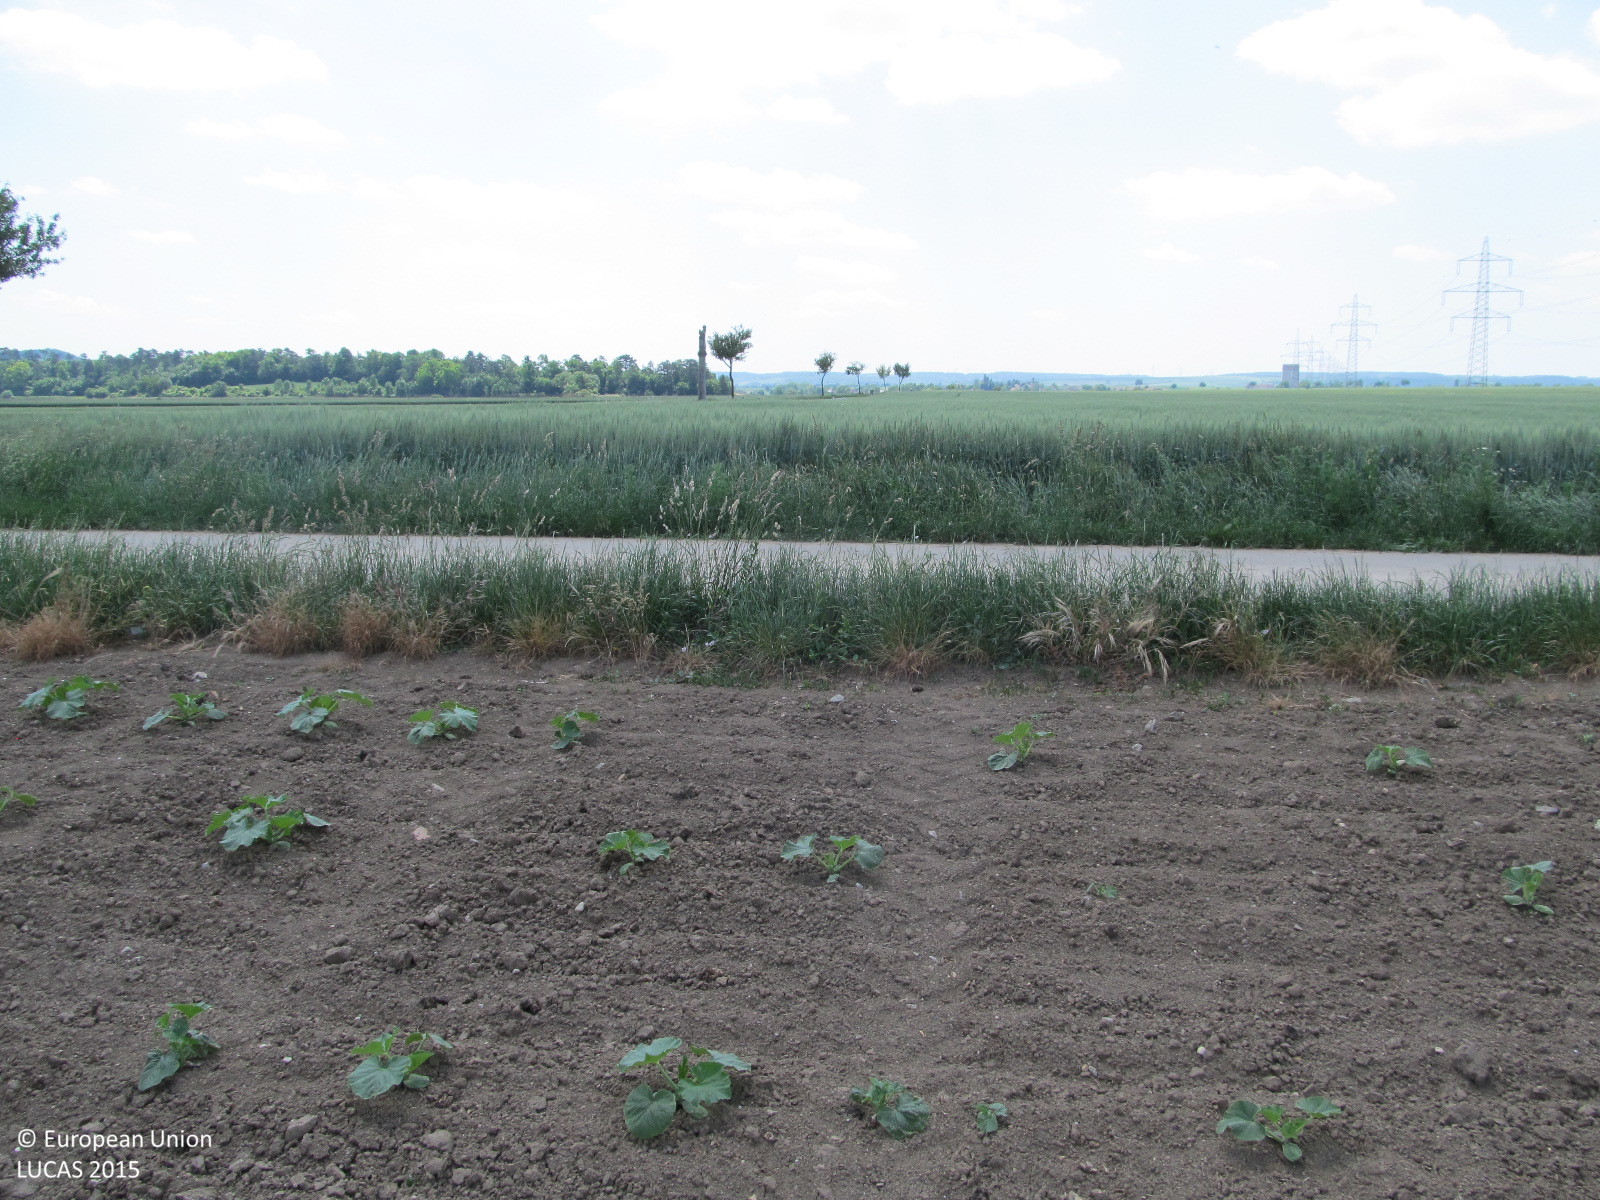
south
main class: Cropland
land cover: Other fibre and oleaginous crops
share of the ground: < 10 %
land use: Agriculture (excluding fallow land and kitchen gardens)
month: June
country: AT
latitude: 48.5693
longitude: 15.9264
